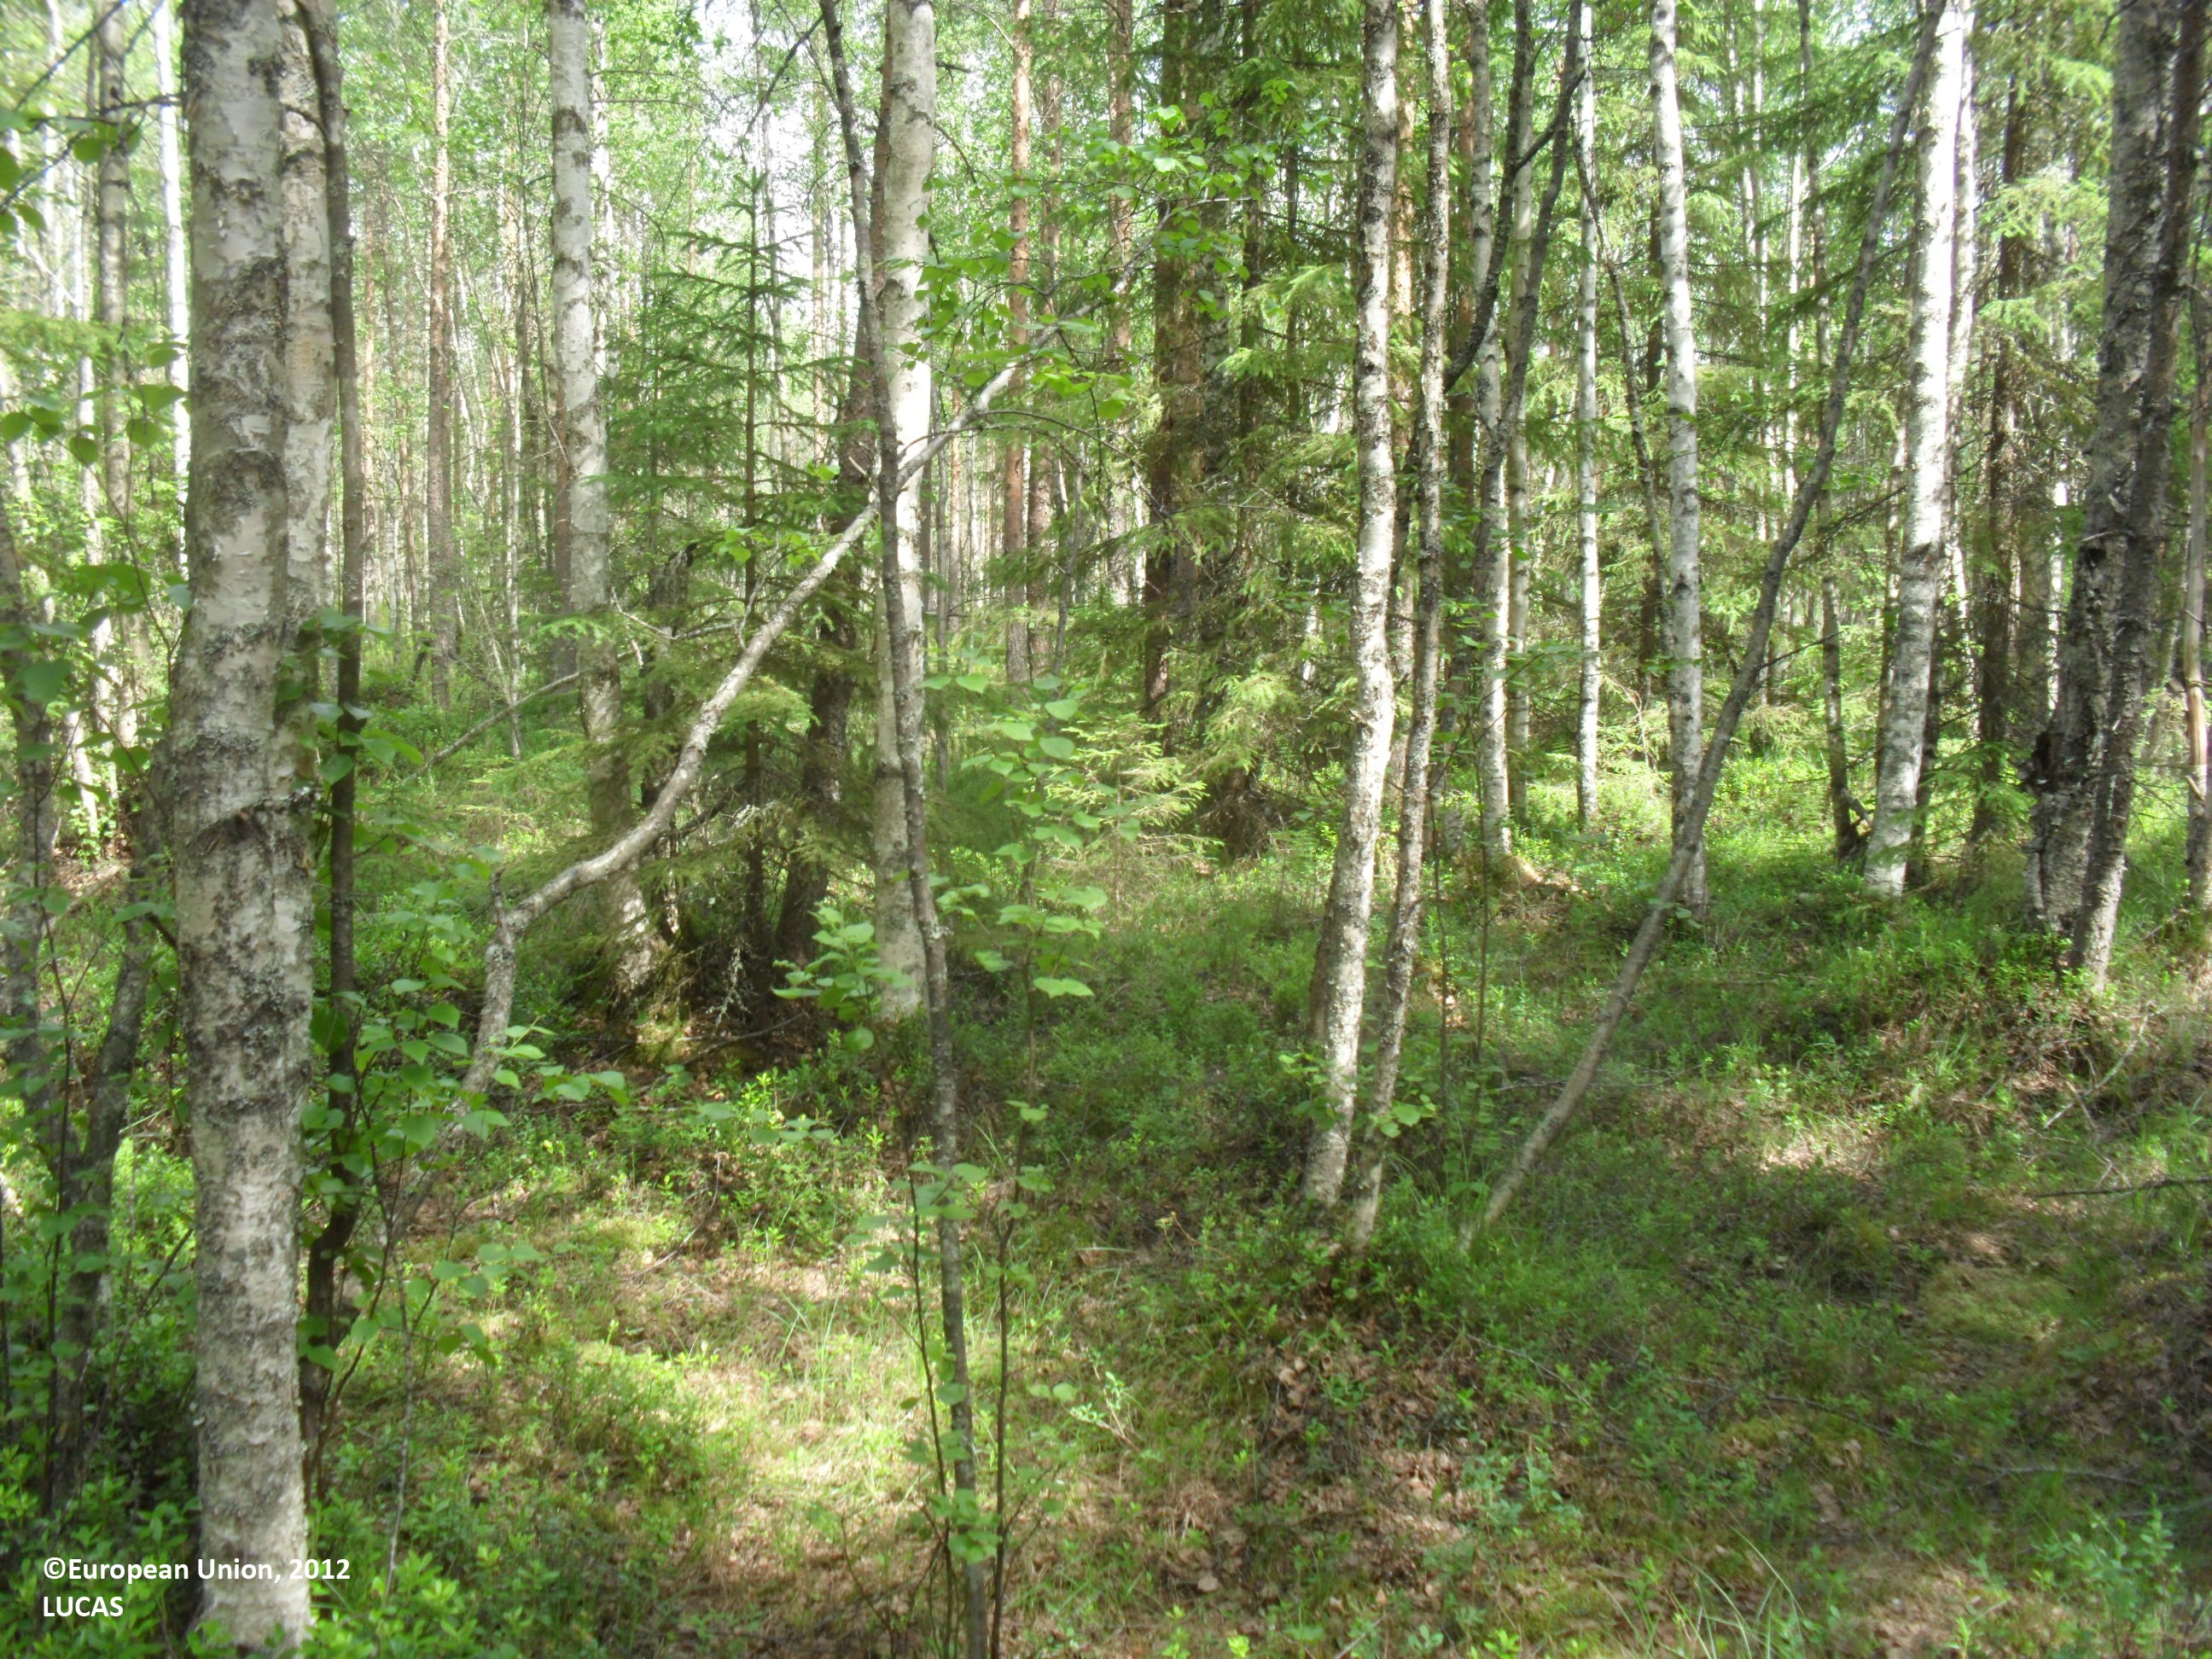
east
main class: Woodland
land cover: Other mixed woodland
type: boreal forest
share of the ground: 50 - 75 %
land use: Forestry
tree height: > 5 m
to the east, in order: Other mixed woodland; Ditches and canals; Other mixed woodland; Ditches and canals; Other mixed woodland; Spruce dominated coniferous woodland; Other mixed woodland
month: July
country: FI
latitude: 63.5513
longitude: 24.0162
